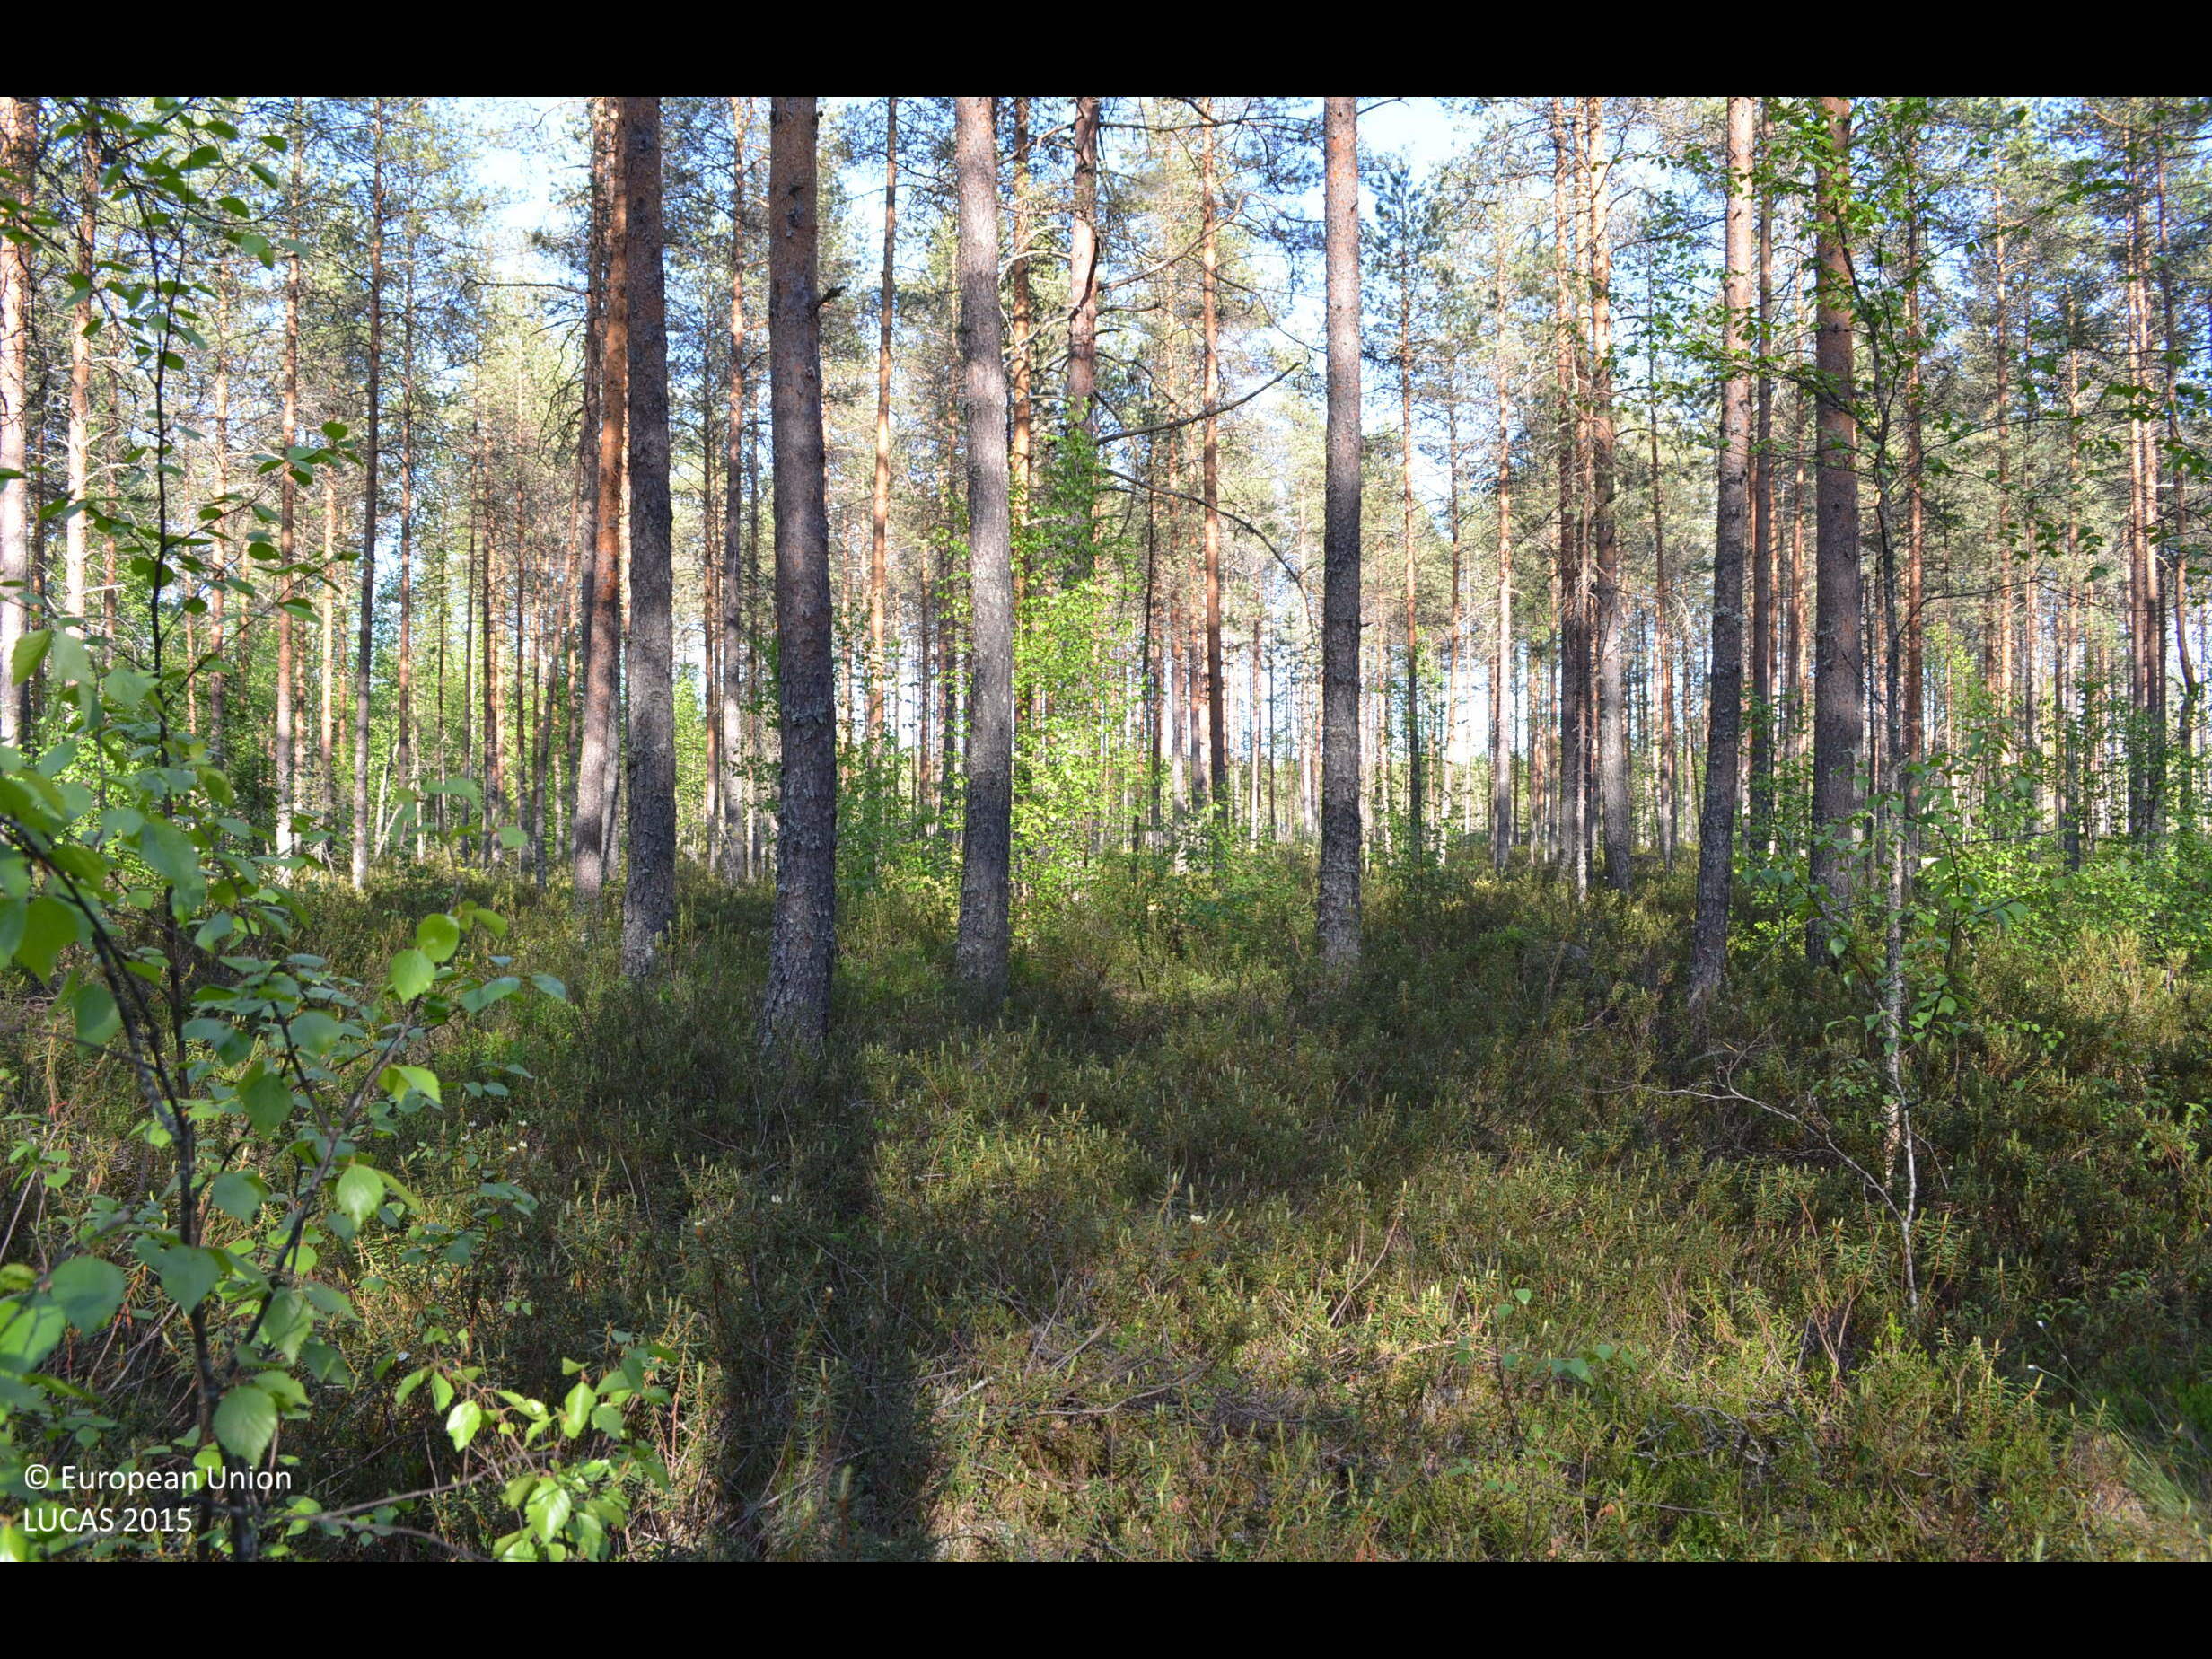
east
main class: Woodland
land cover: Pine dominated coniferous woodland
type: boreal forest
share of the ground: 50 - 75 %
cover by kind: coniferous forest trees 70 %, shrubs 30 %
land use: Forestry
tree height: > 5 m
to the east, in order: Pine dominated coniferous woodland; Ditches and canals; Pine dominated coniferous woodland; Ditches and canals; Pine dominated coniferous woodland; Ditches and canals; Pine dominated coniferous woodland; Shrubland without tree cover; Ditches and canals; Pine dominated coniferous woodland; Ditches and canals; Pine dominated coniferous woodland
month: June
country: FI
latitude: 61.8910
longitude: 23.2958
